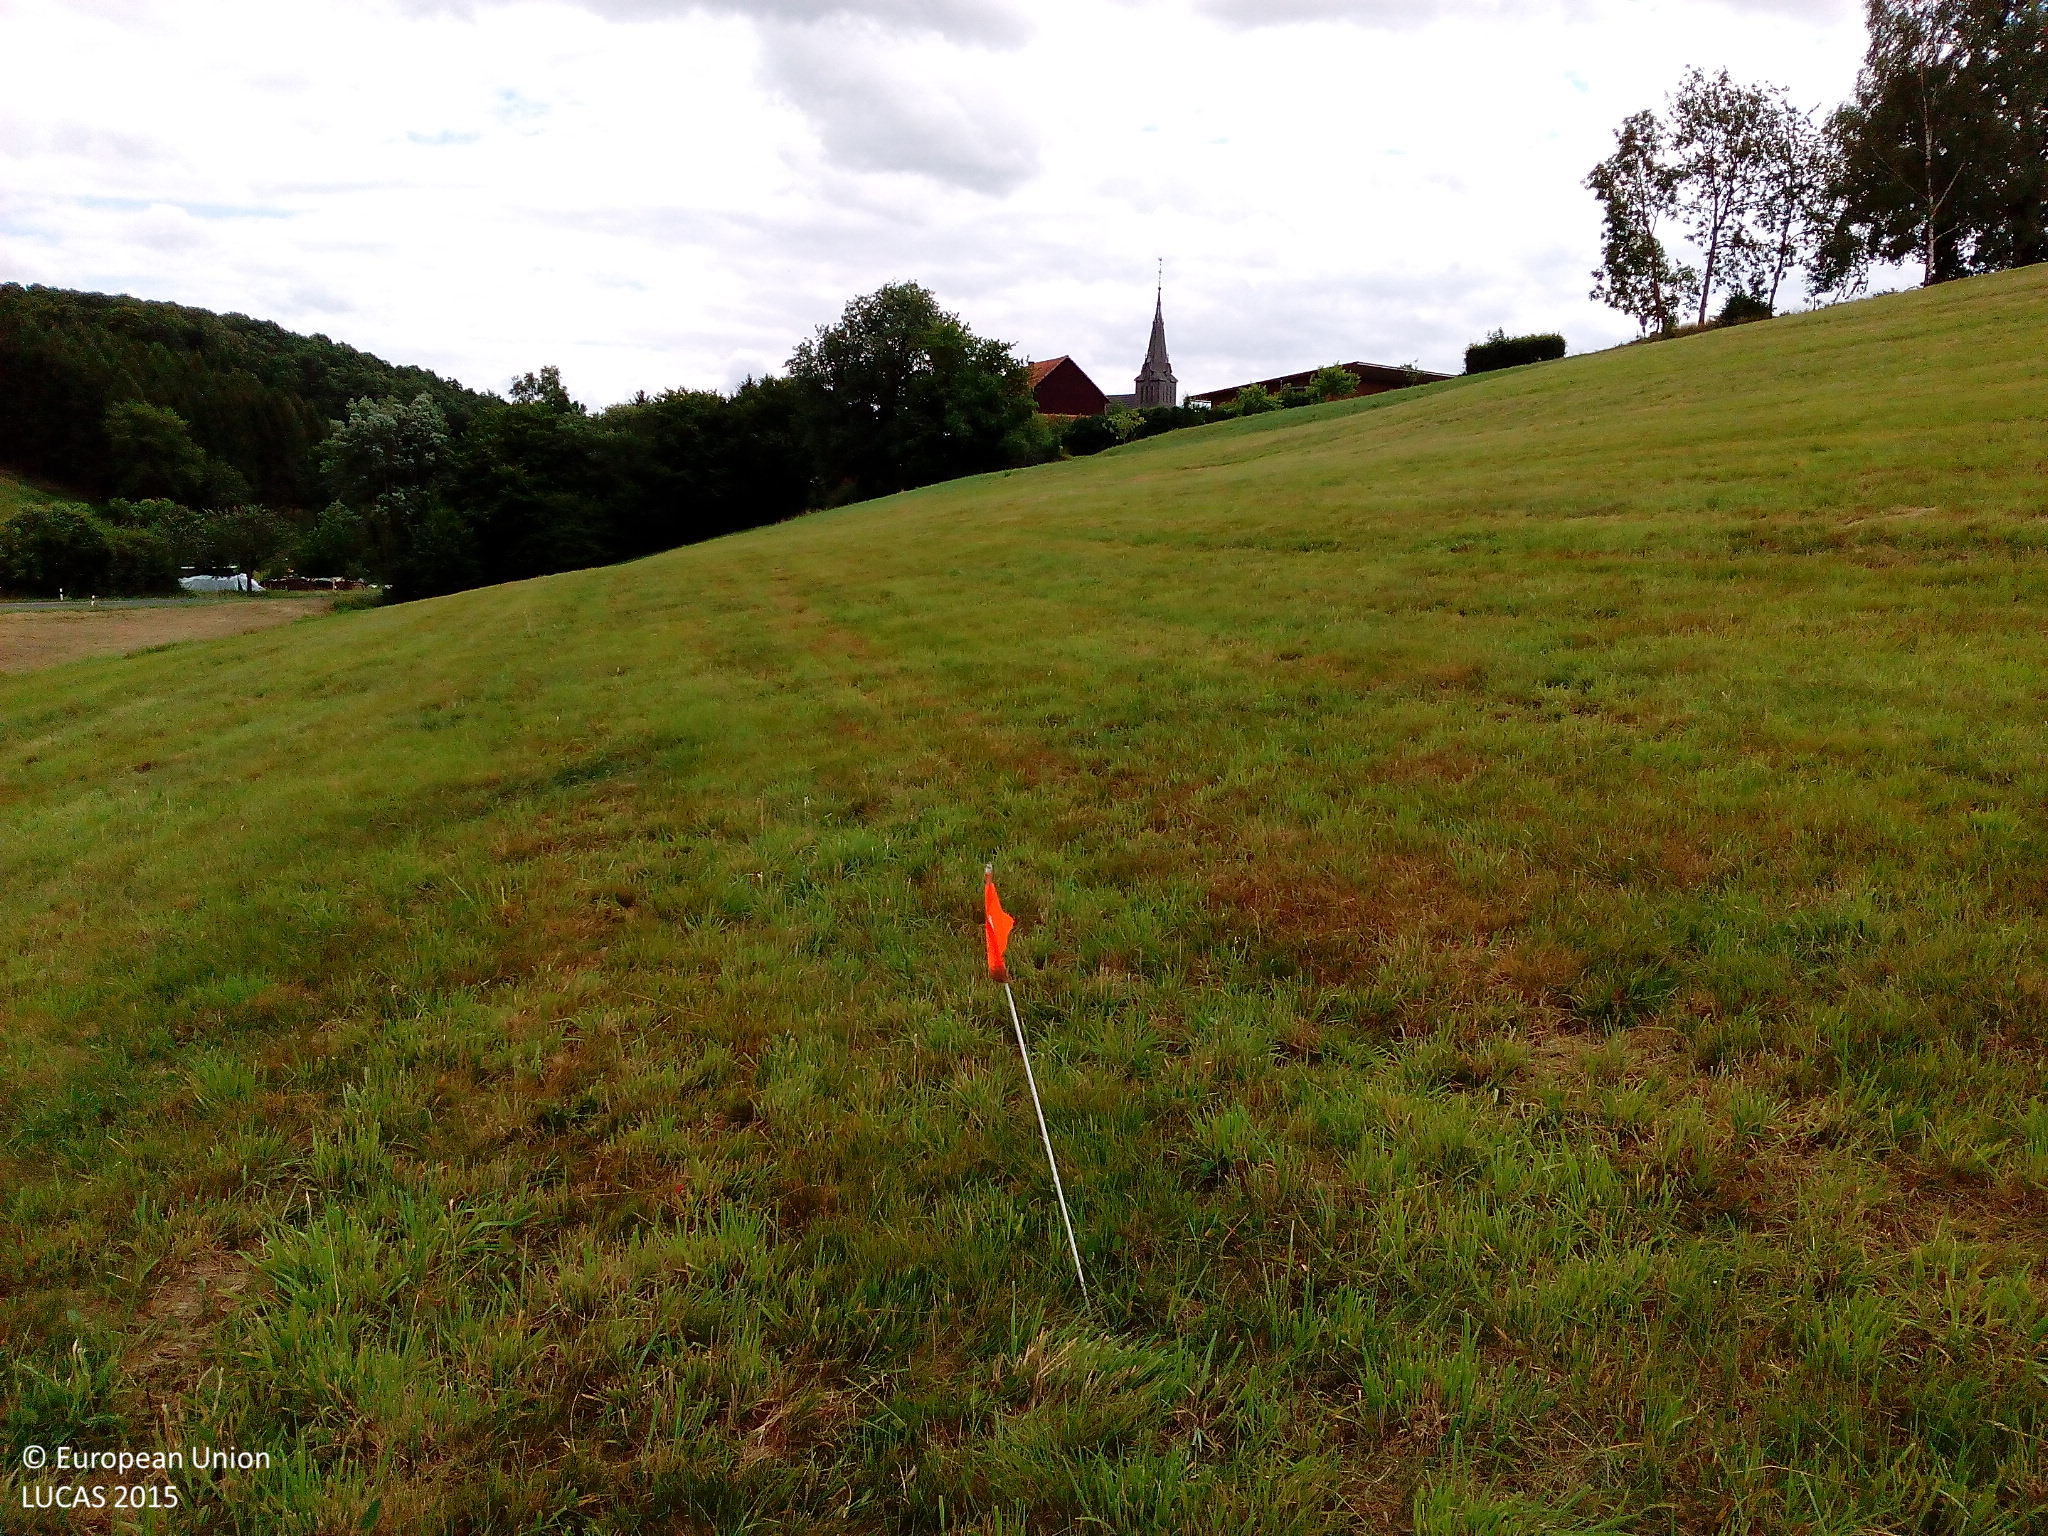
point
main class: Grassland
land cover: Grassland without tree/shrub cover
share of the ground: > 75 %
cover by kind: herbaceous plants 100 %
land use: Agriculture (excluding fallow land and kitchen gardens)
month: July
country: DE
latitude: 51.1011
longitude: 9.8715
